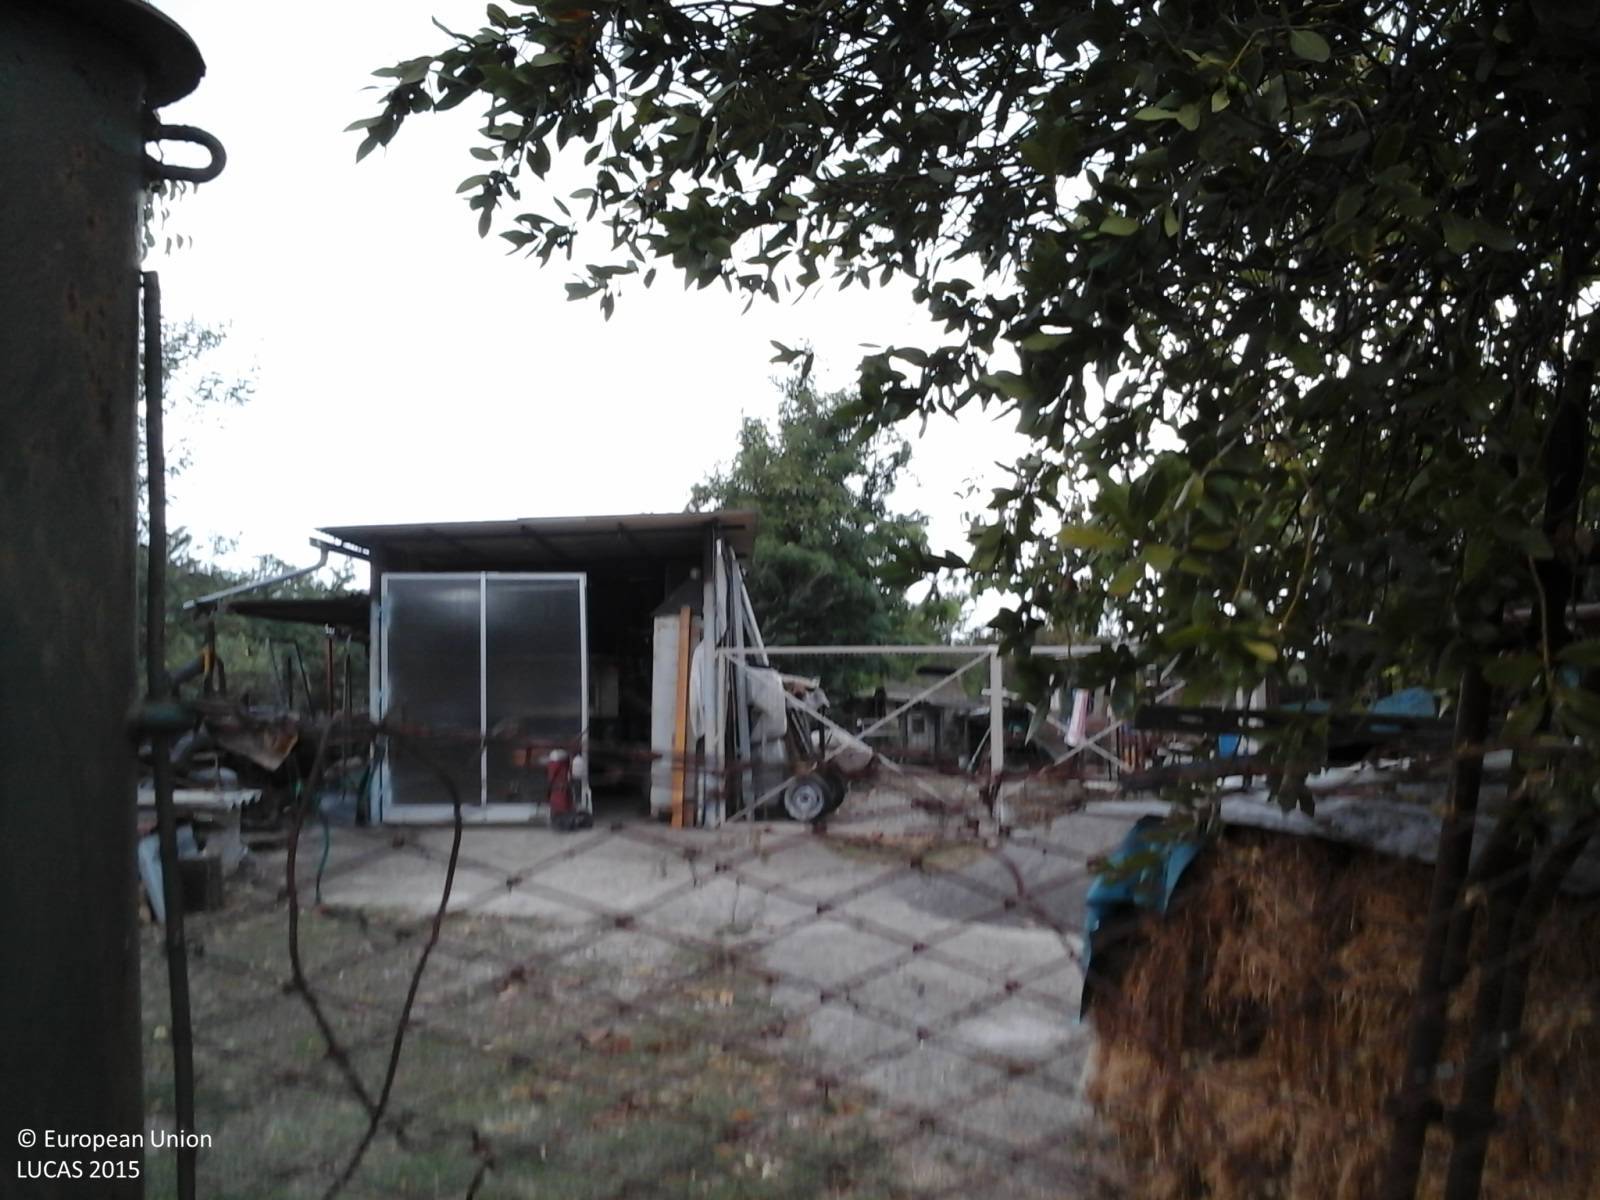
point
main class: Woodland
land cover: Broadleaved woodland
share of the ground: > 75 %
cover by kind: broadleaved forest trees 100 %
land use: Residential
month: September
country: IT
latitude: 42.4638
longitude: 12.3636
